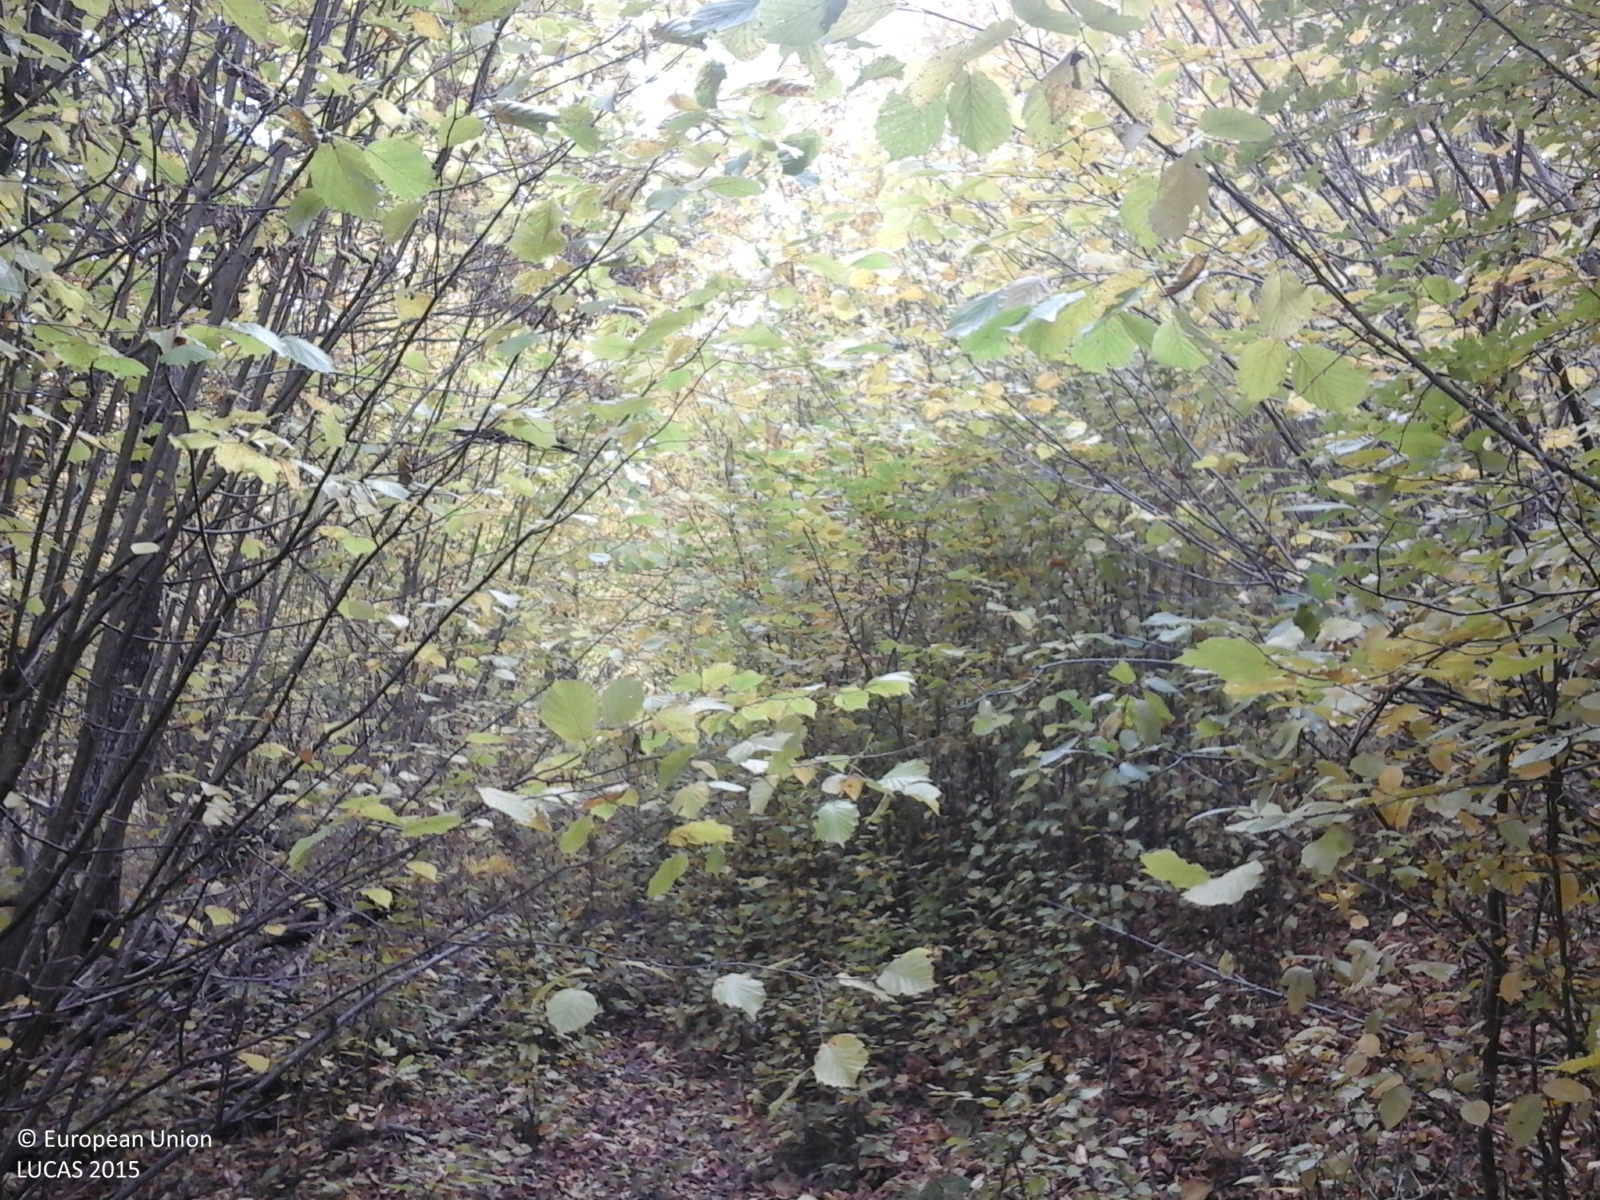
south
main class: Woodland
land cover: Broadleaved woodland
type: beech forest
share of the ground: > 75 %
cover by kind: broadleaved forest trees 100 %
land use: Forestry
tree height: > 5 m
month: October
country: RO
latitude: 46.4546
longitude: 25.4041
